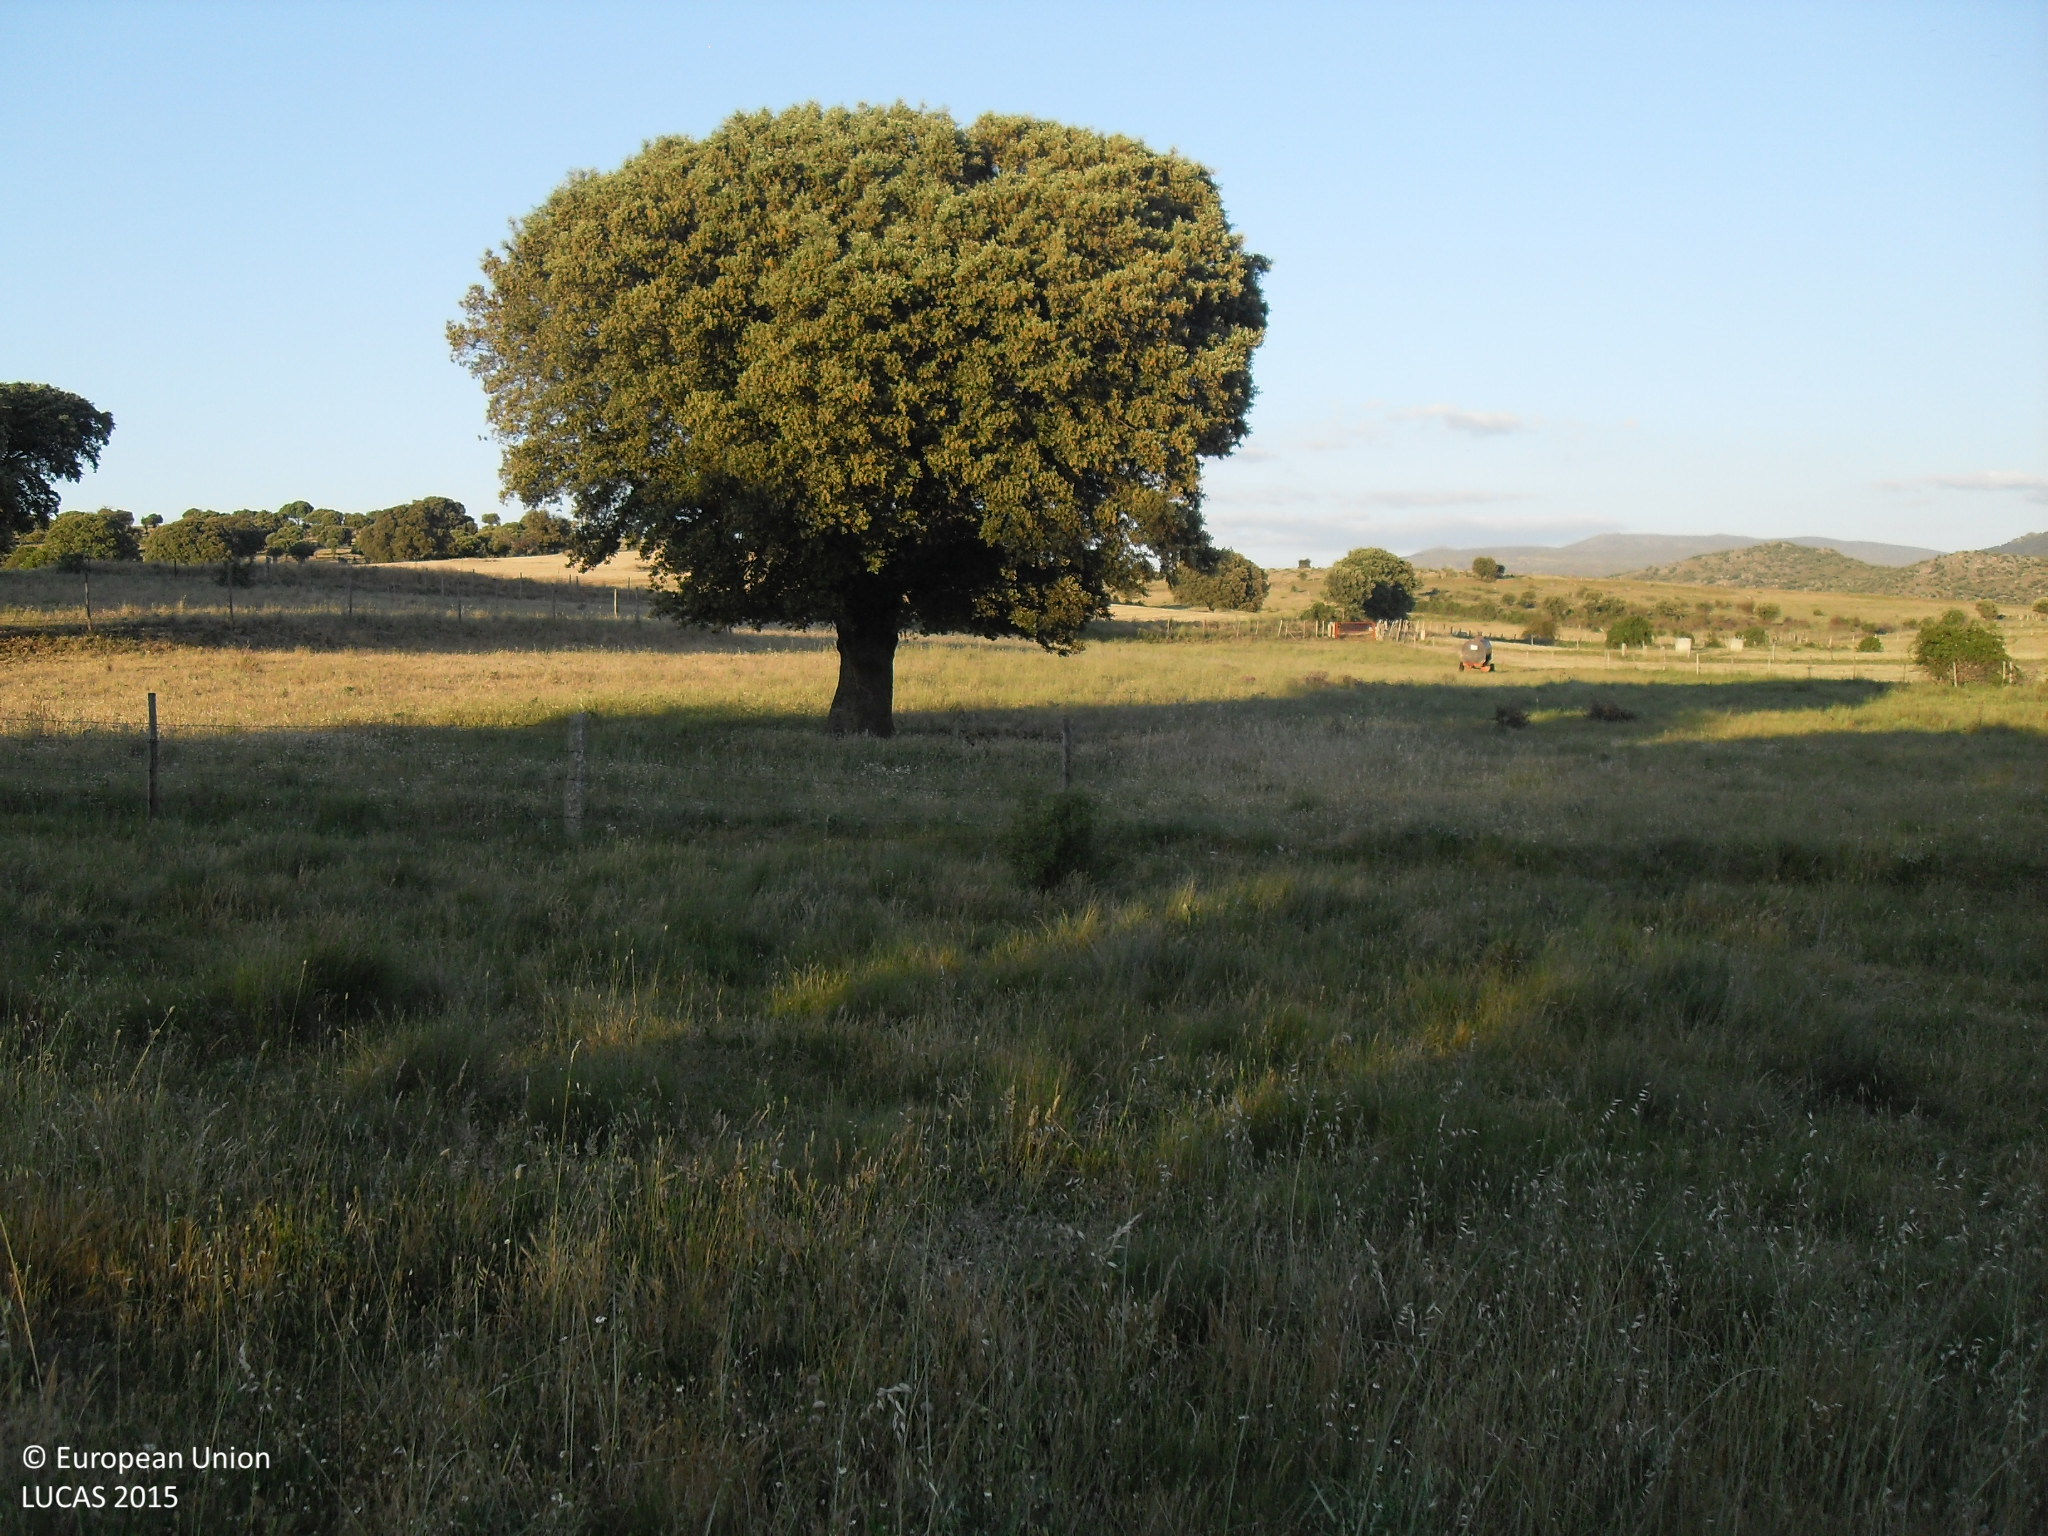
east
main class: Grassland
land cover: Grassland without tree/shrub cover
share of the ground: > 75 %
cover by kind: herbaceous plants 100 %
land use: Agriculture (excluding fallow land and kitchen gardens)
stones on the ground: < 10 %
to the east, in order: Grassland without tree/shrub cover; Fences; Grassland without tree/shrub cover; Single bushes/trees; Grassland without tree/shrub cover; Fences; Grass margins; Tracks; Grass margins; Fences; Oats
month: May
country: ES
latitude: 40.5321
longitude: -5.2809
